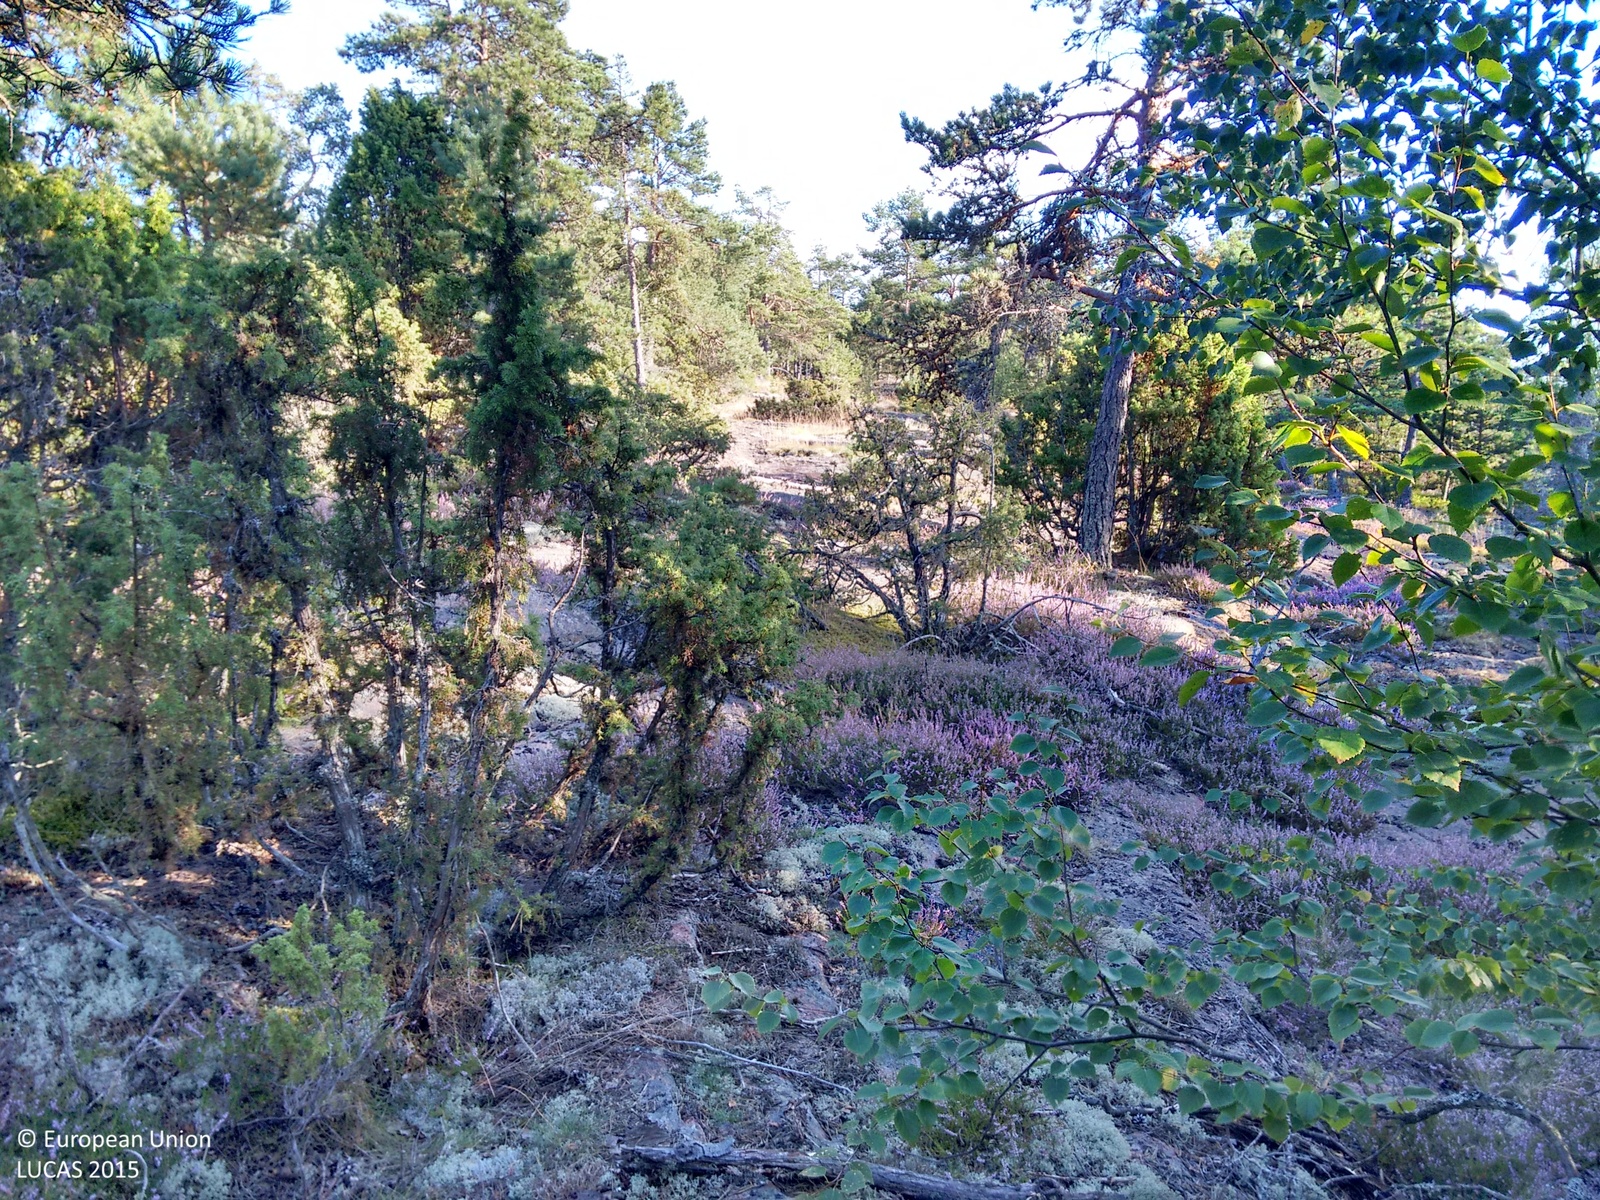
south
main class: Woodland
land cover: Pine dominated coniferous woodland
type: hemiboreal forest and nemoral coniferous forest and mixed broadleaved-coniferous forest
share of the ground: > 75 %
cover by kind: coniferous forest trees 70 %, broadleaved forest trees 15 %, lichens and mosses 10 %, unconsolidated bare surface 5 %
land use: Amenities, museums, leisure
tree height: > 5 m
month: August
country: FI
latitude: 60.1741
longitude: 19.9382
